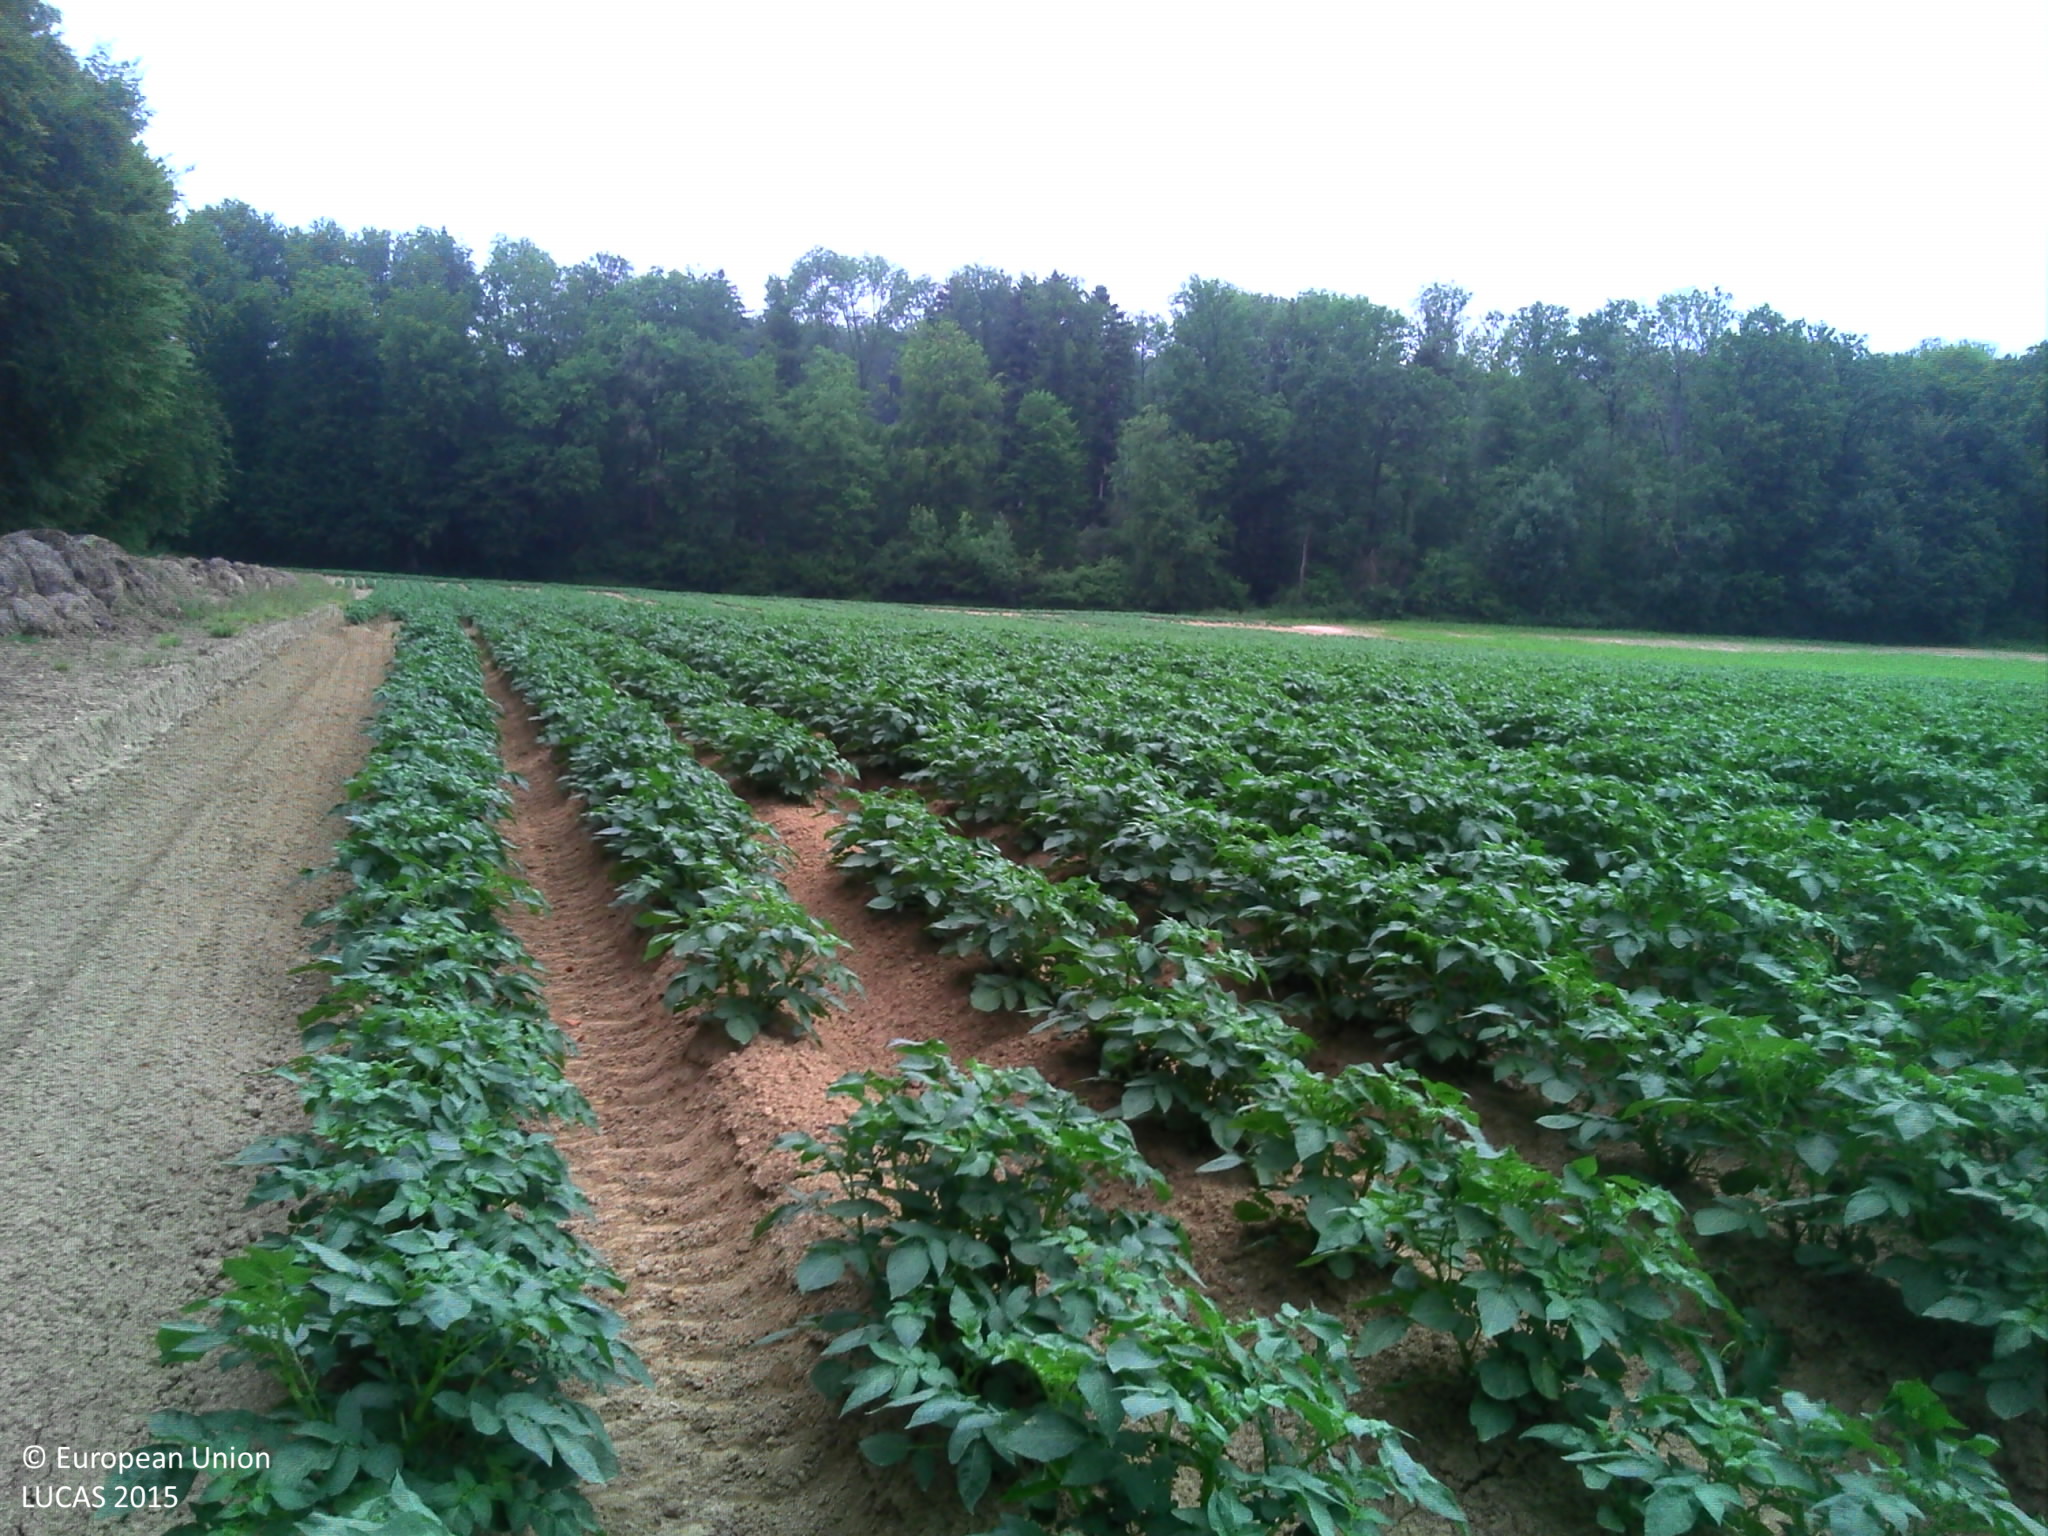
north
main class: Cropland
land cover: Potatoes
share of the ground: 50 - 75 %
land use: Agriculture (excluding fallow land and kitchen gardens)
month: June
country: FR
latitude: 47.5108
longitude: 7.4921
